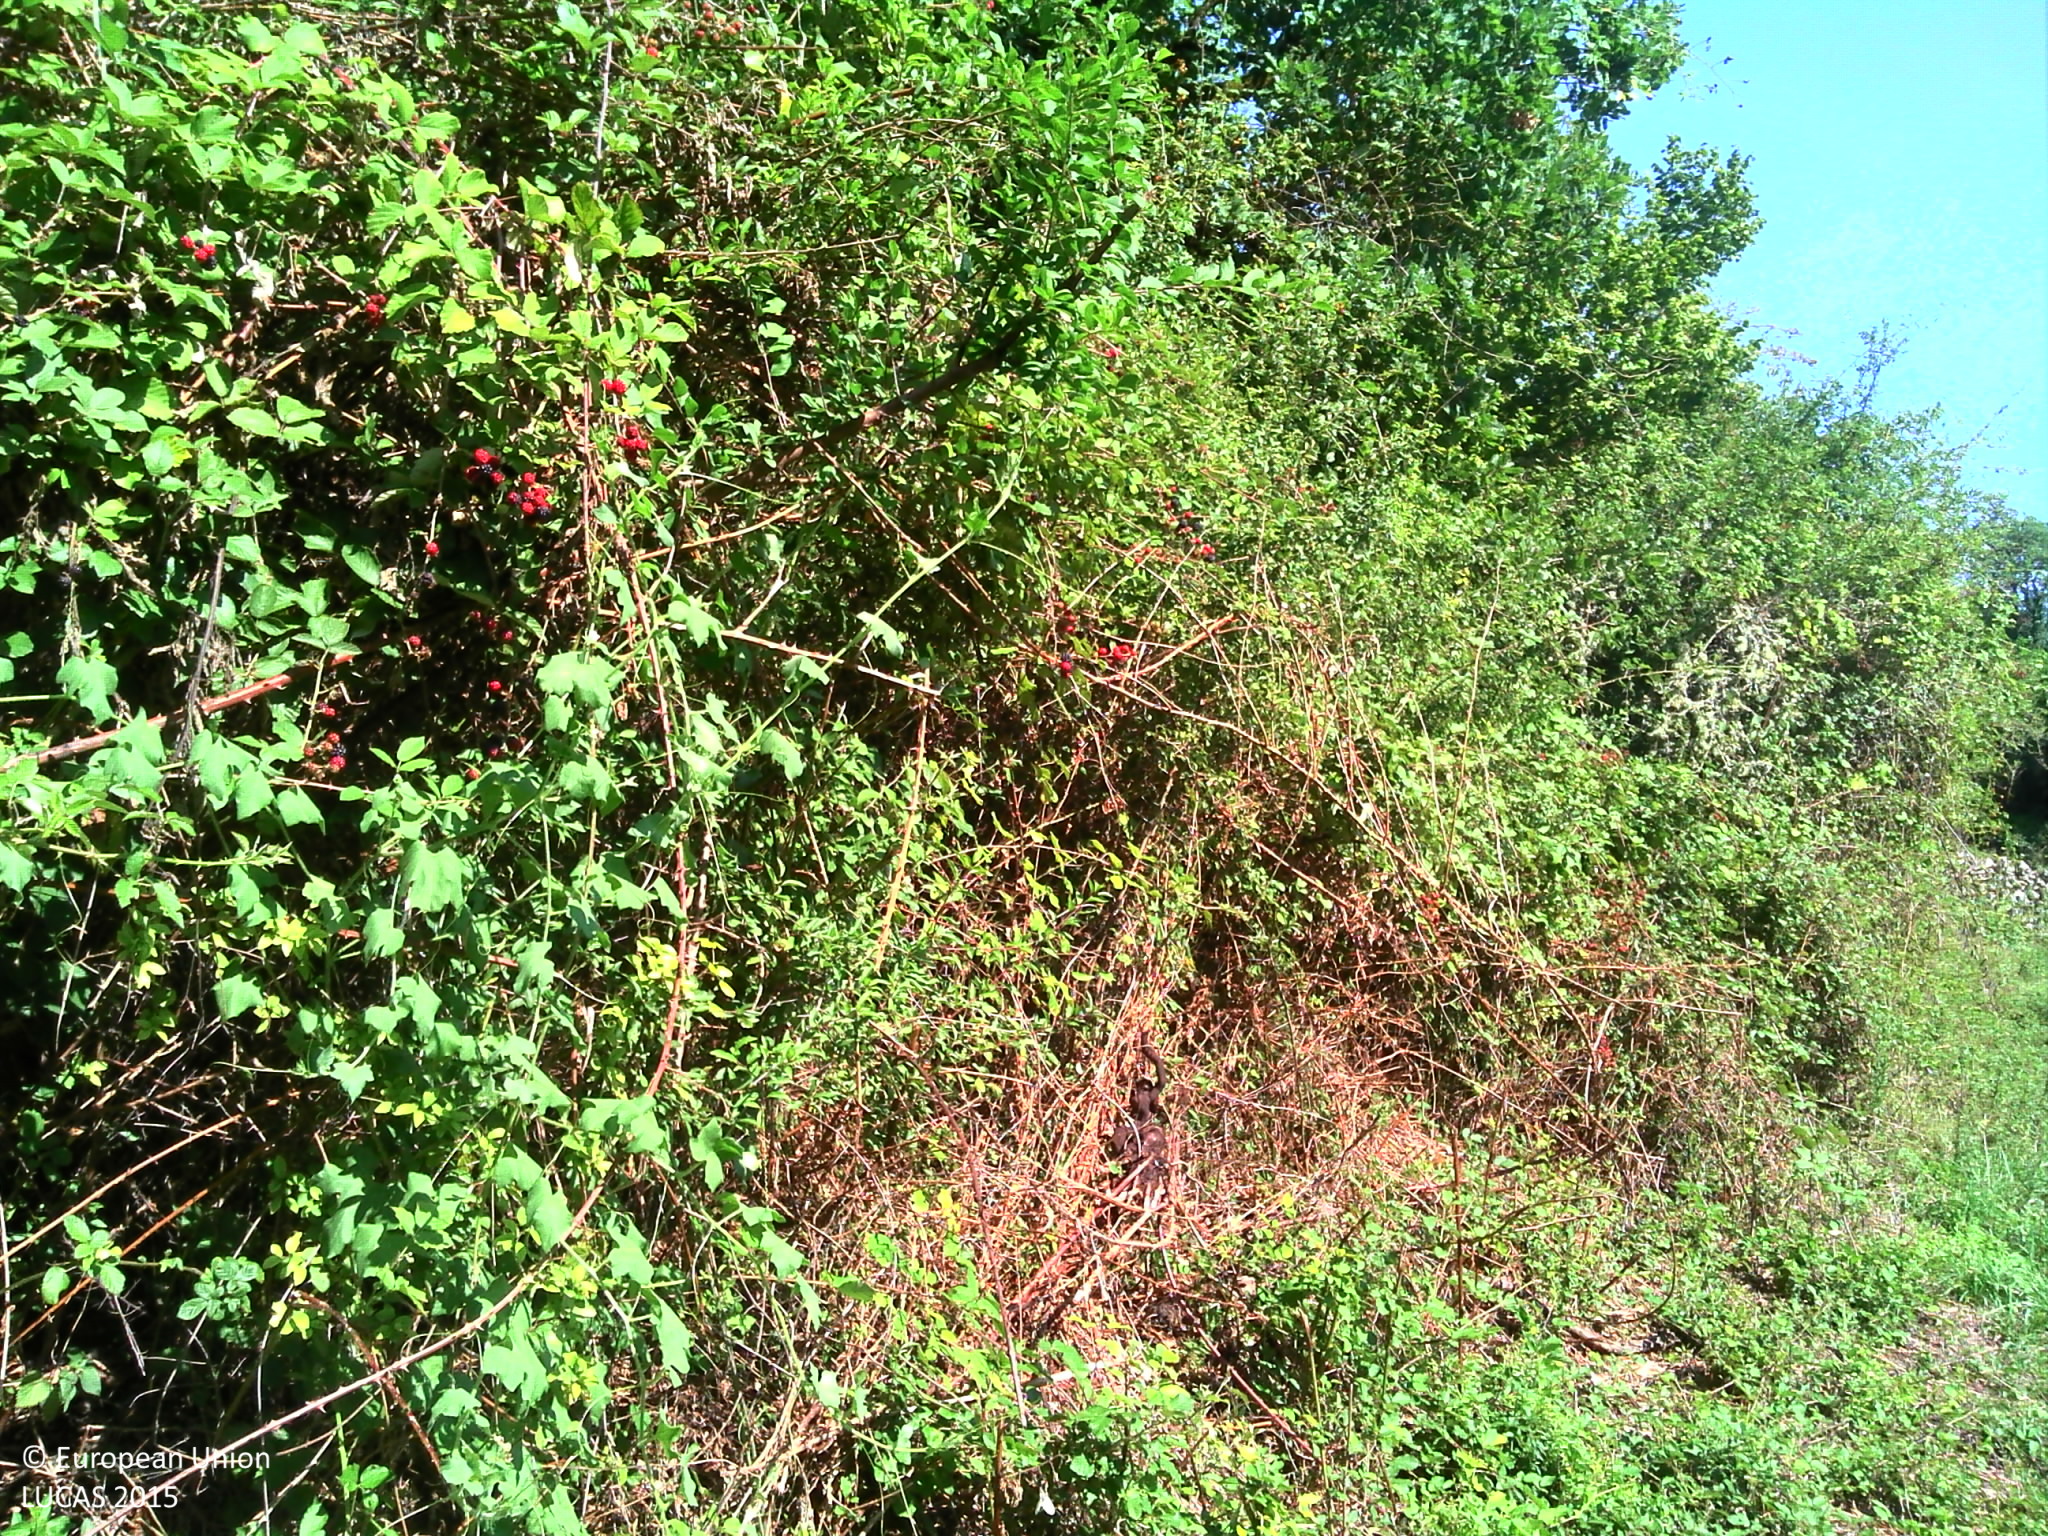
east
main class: Woodland
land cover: Broadleaved woodland
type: acidophilous oak and oak-birch forest
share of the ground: > 75 %
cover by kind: broadleaved forest trees 40 %, shrubs 30 %, herbaceous plants 20 %, unconsolidated bare surface 10 %
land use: Forestry
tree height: > 5 m
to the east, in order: Broadleaved woodland; Shrubland without tree cover; Tracks; Broadleaved woodland; Grassland with sparse tree/shrub cover; Fences; Tracks; Broadleaved woodland; Electric lines; Broadleaved woodland
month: August
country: FR
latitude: 45.3943
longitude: 0.4194
